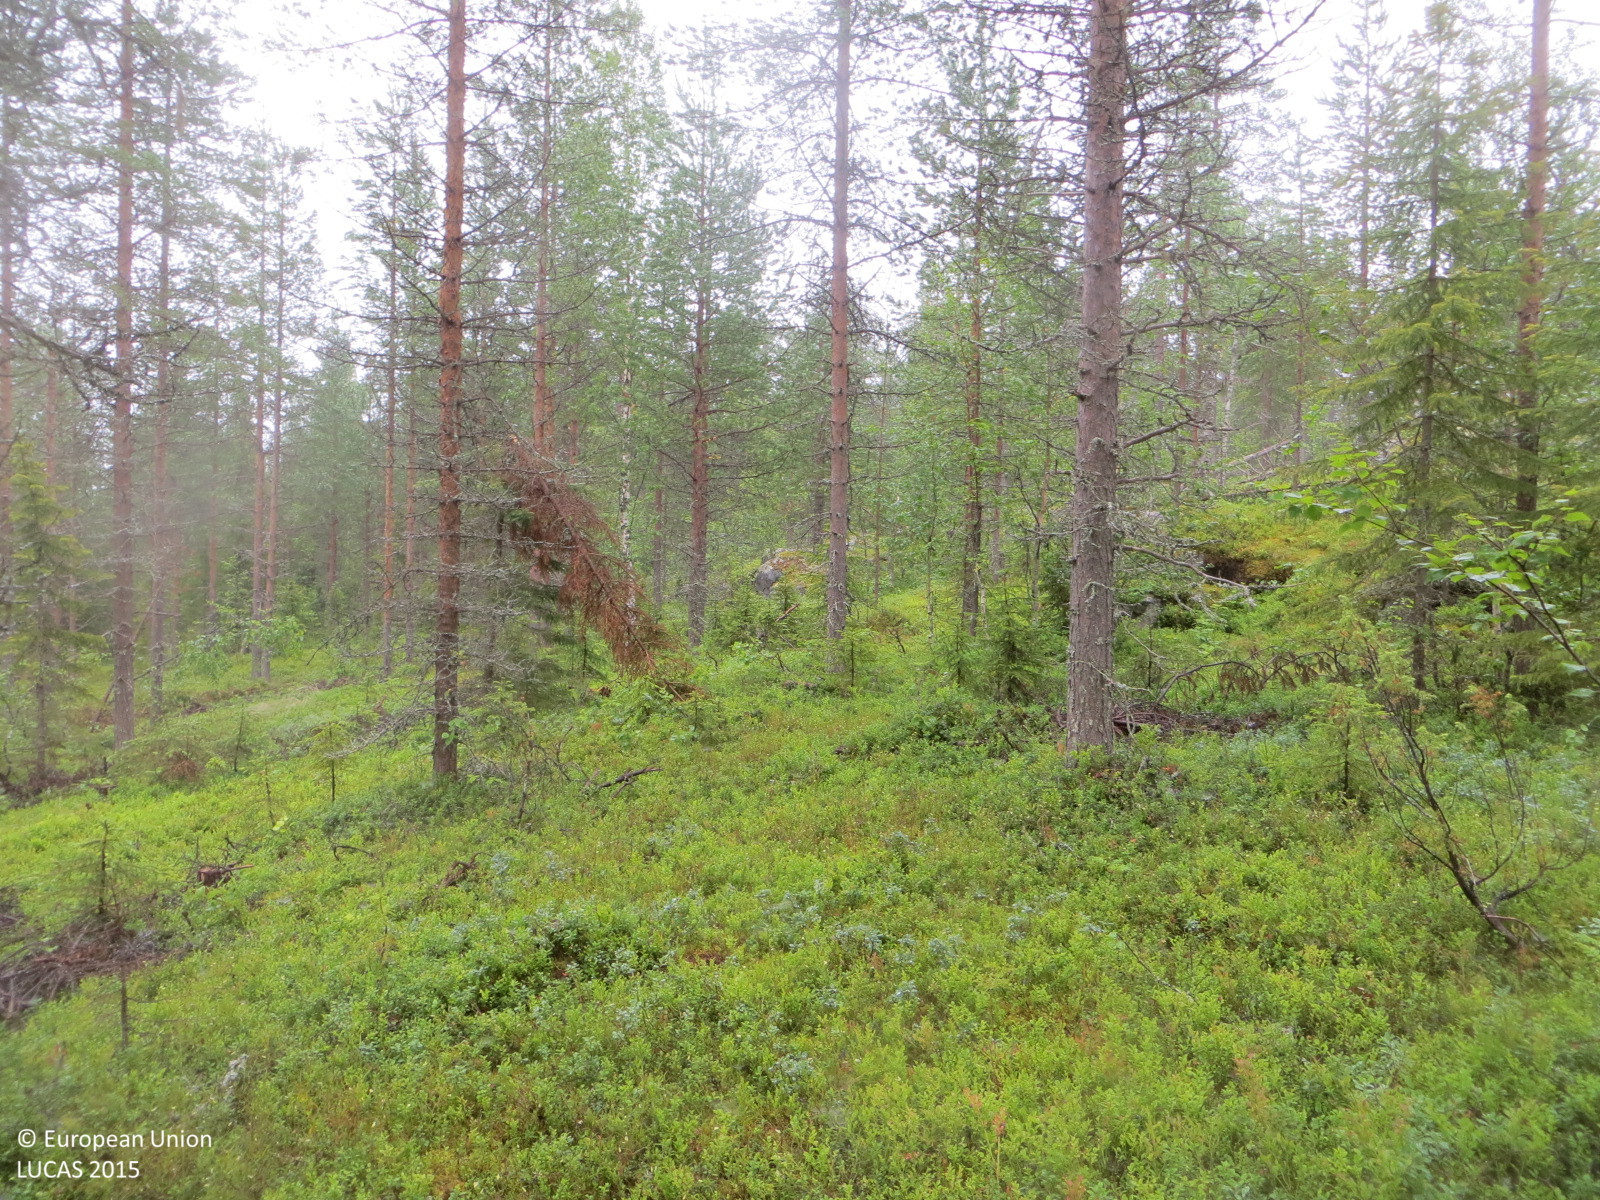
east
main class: Woodland
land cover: Pine dominated coniferous woodland
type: boreal forest
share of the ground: 50 - 75 %
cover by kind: coniferous forest trees 50 %, shrubs 50 %
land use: Forestry
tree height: > 5 m
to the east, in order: Pine dominated coniferous woodland; Pine dominated mixed woodland; Other mixed woodland
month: August
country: FI
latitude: 66.0713
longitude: 25.5145
